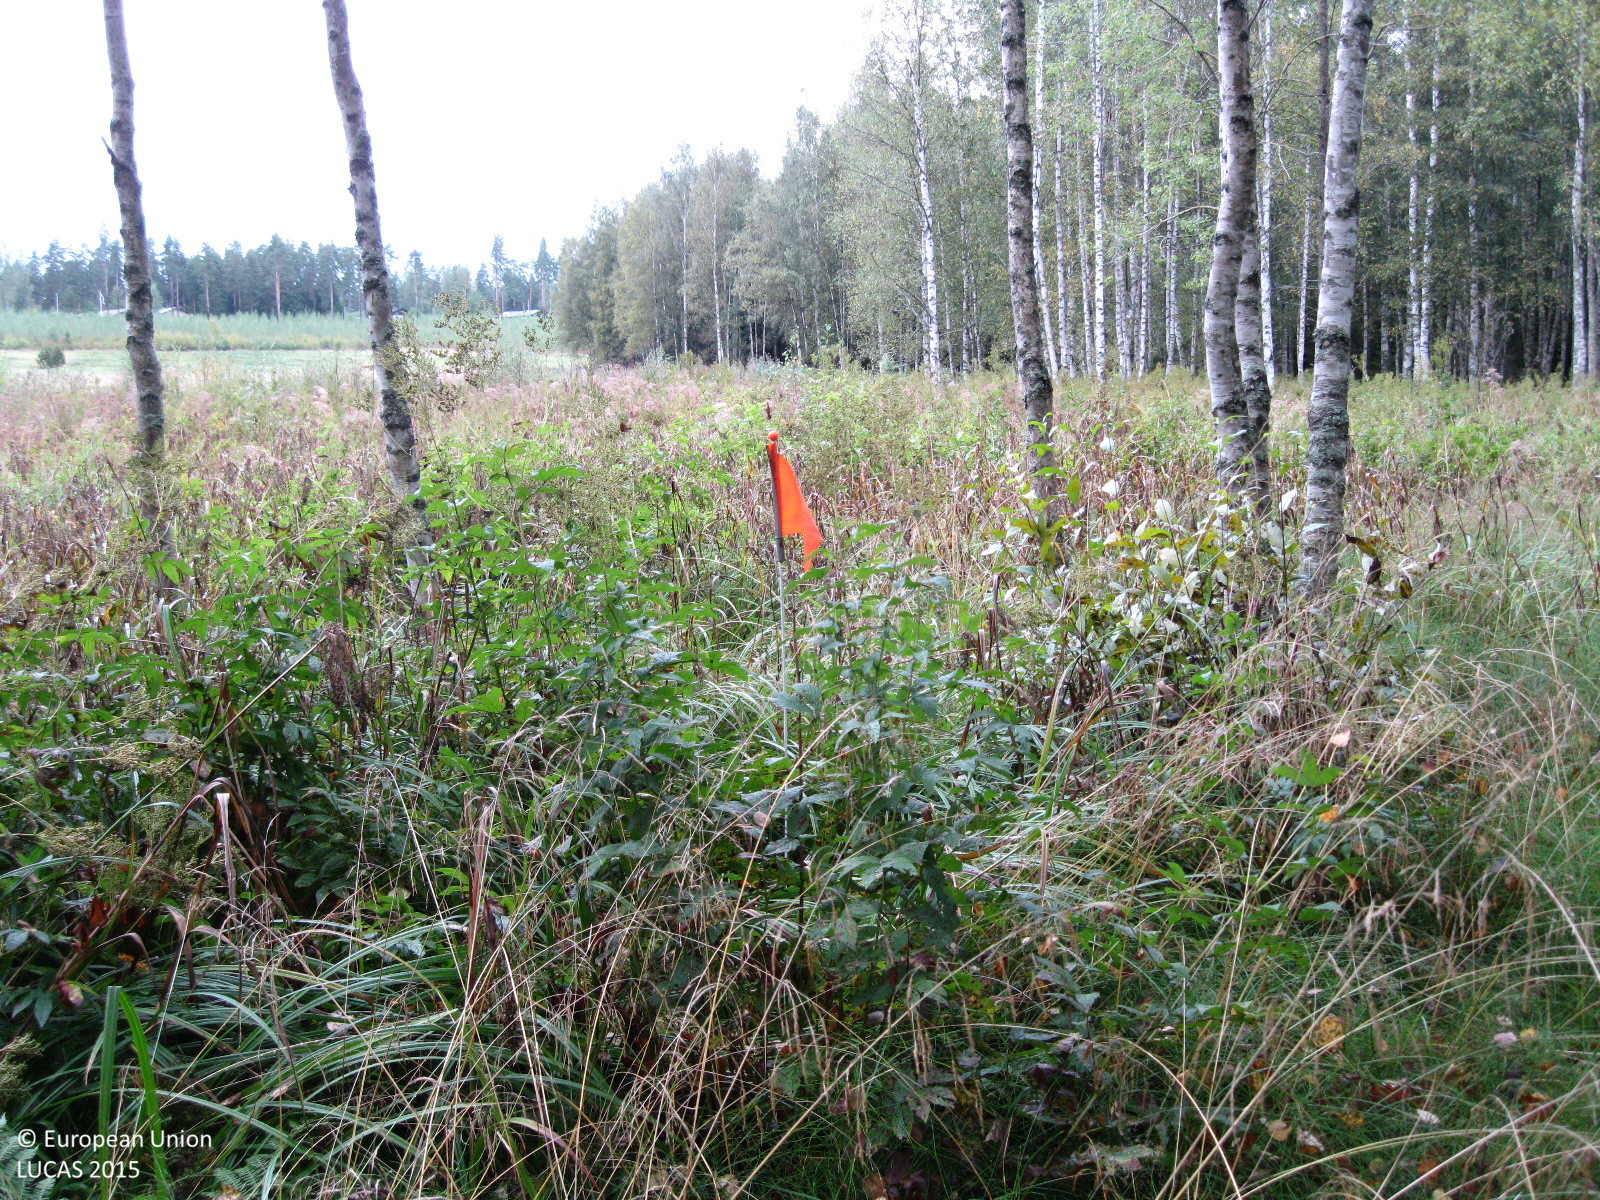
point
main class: Woodland
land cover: Broadleaved woodland
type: boreal forest
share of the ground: 50 - 75 %
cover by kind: broadleaved forest trees 50 %, herbaceous plants 45 %, coniferous forest trees 5 %
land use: Forestry
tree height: > 5 m
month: September
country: FI
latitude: 60.4752
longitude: 24.6447
